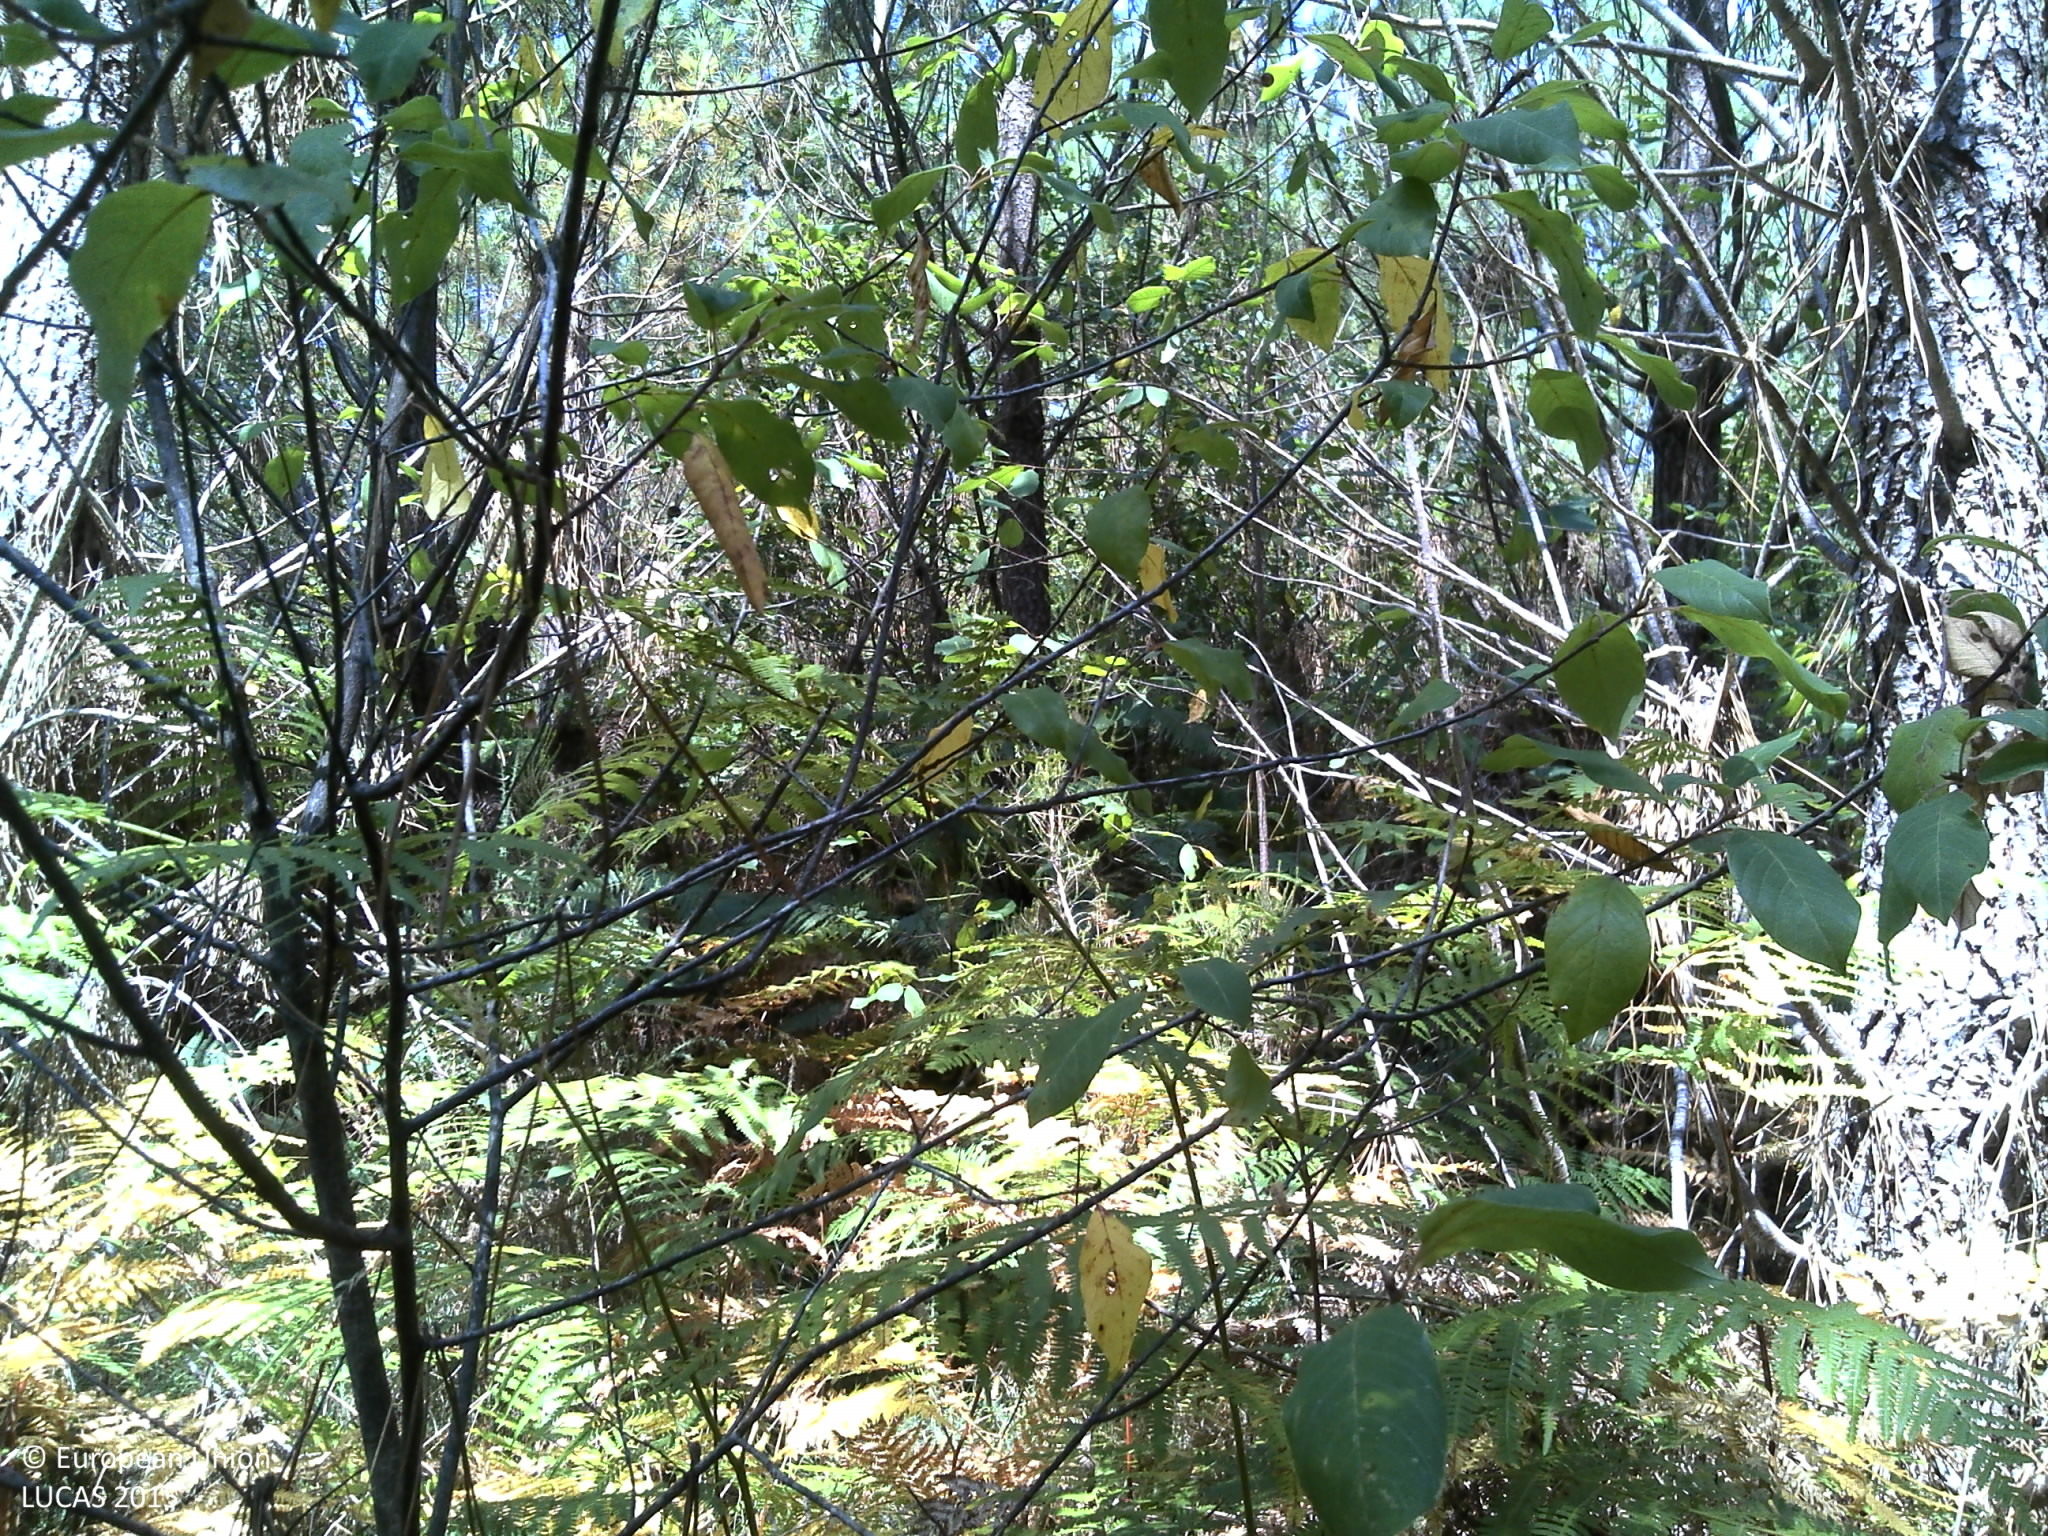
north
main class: Woodland
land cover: Pine dominated coniferous woodland
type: coniferous forest of the mediterranean region
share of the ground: > 75 %
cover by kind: coniferous forest trees 60 %, shrubs 30 %, herbaceous plants 5 %, lichens and mosses 5 %
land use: Forestry
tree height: > 5 m
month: August
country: FR
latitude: 44.9830
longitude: -0.9935
